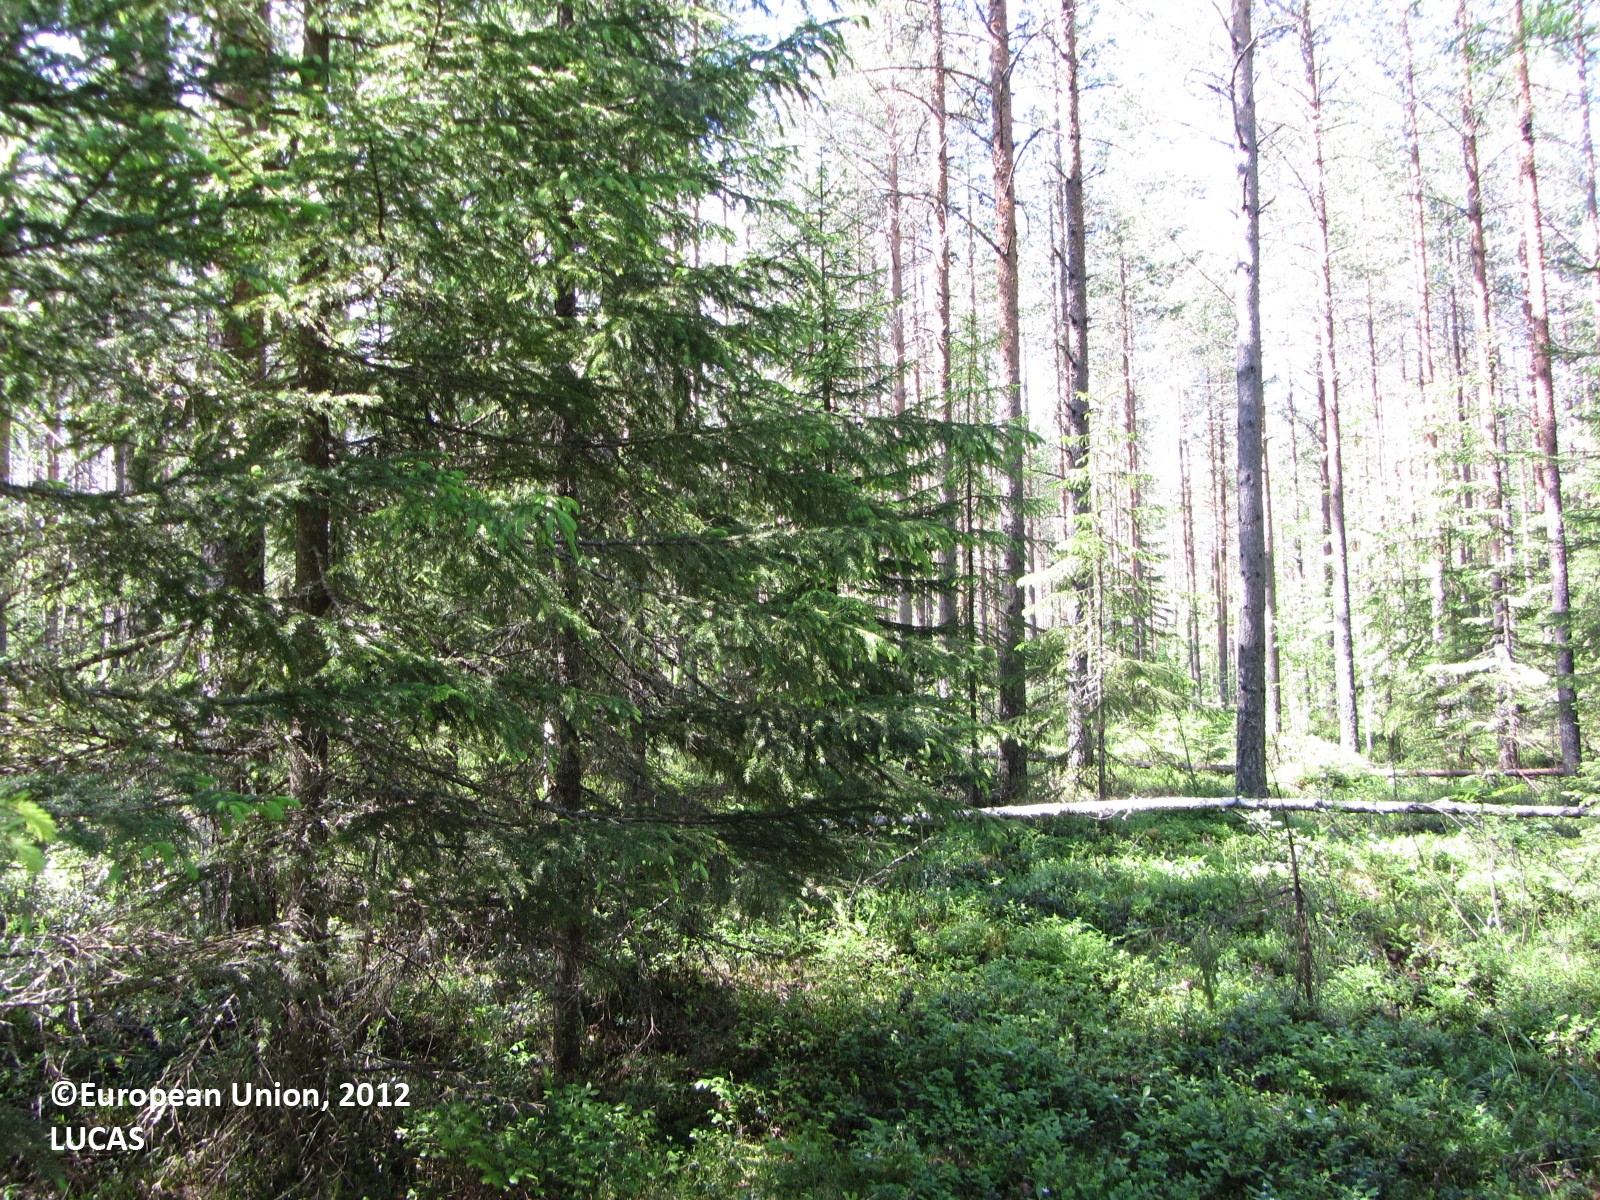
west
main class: Woodland
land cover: Spruce dominated coniferous woodland
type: boreal forest
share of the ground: > 75 %
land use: Forestry
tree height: > 5 m
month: June
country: FI
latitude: 62.1832
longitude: 25.0295
